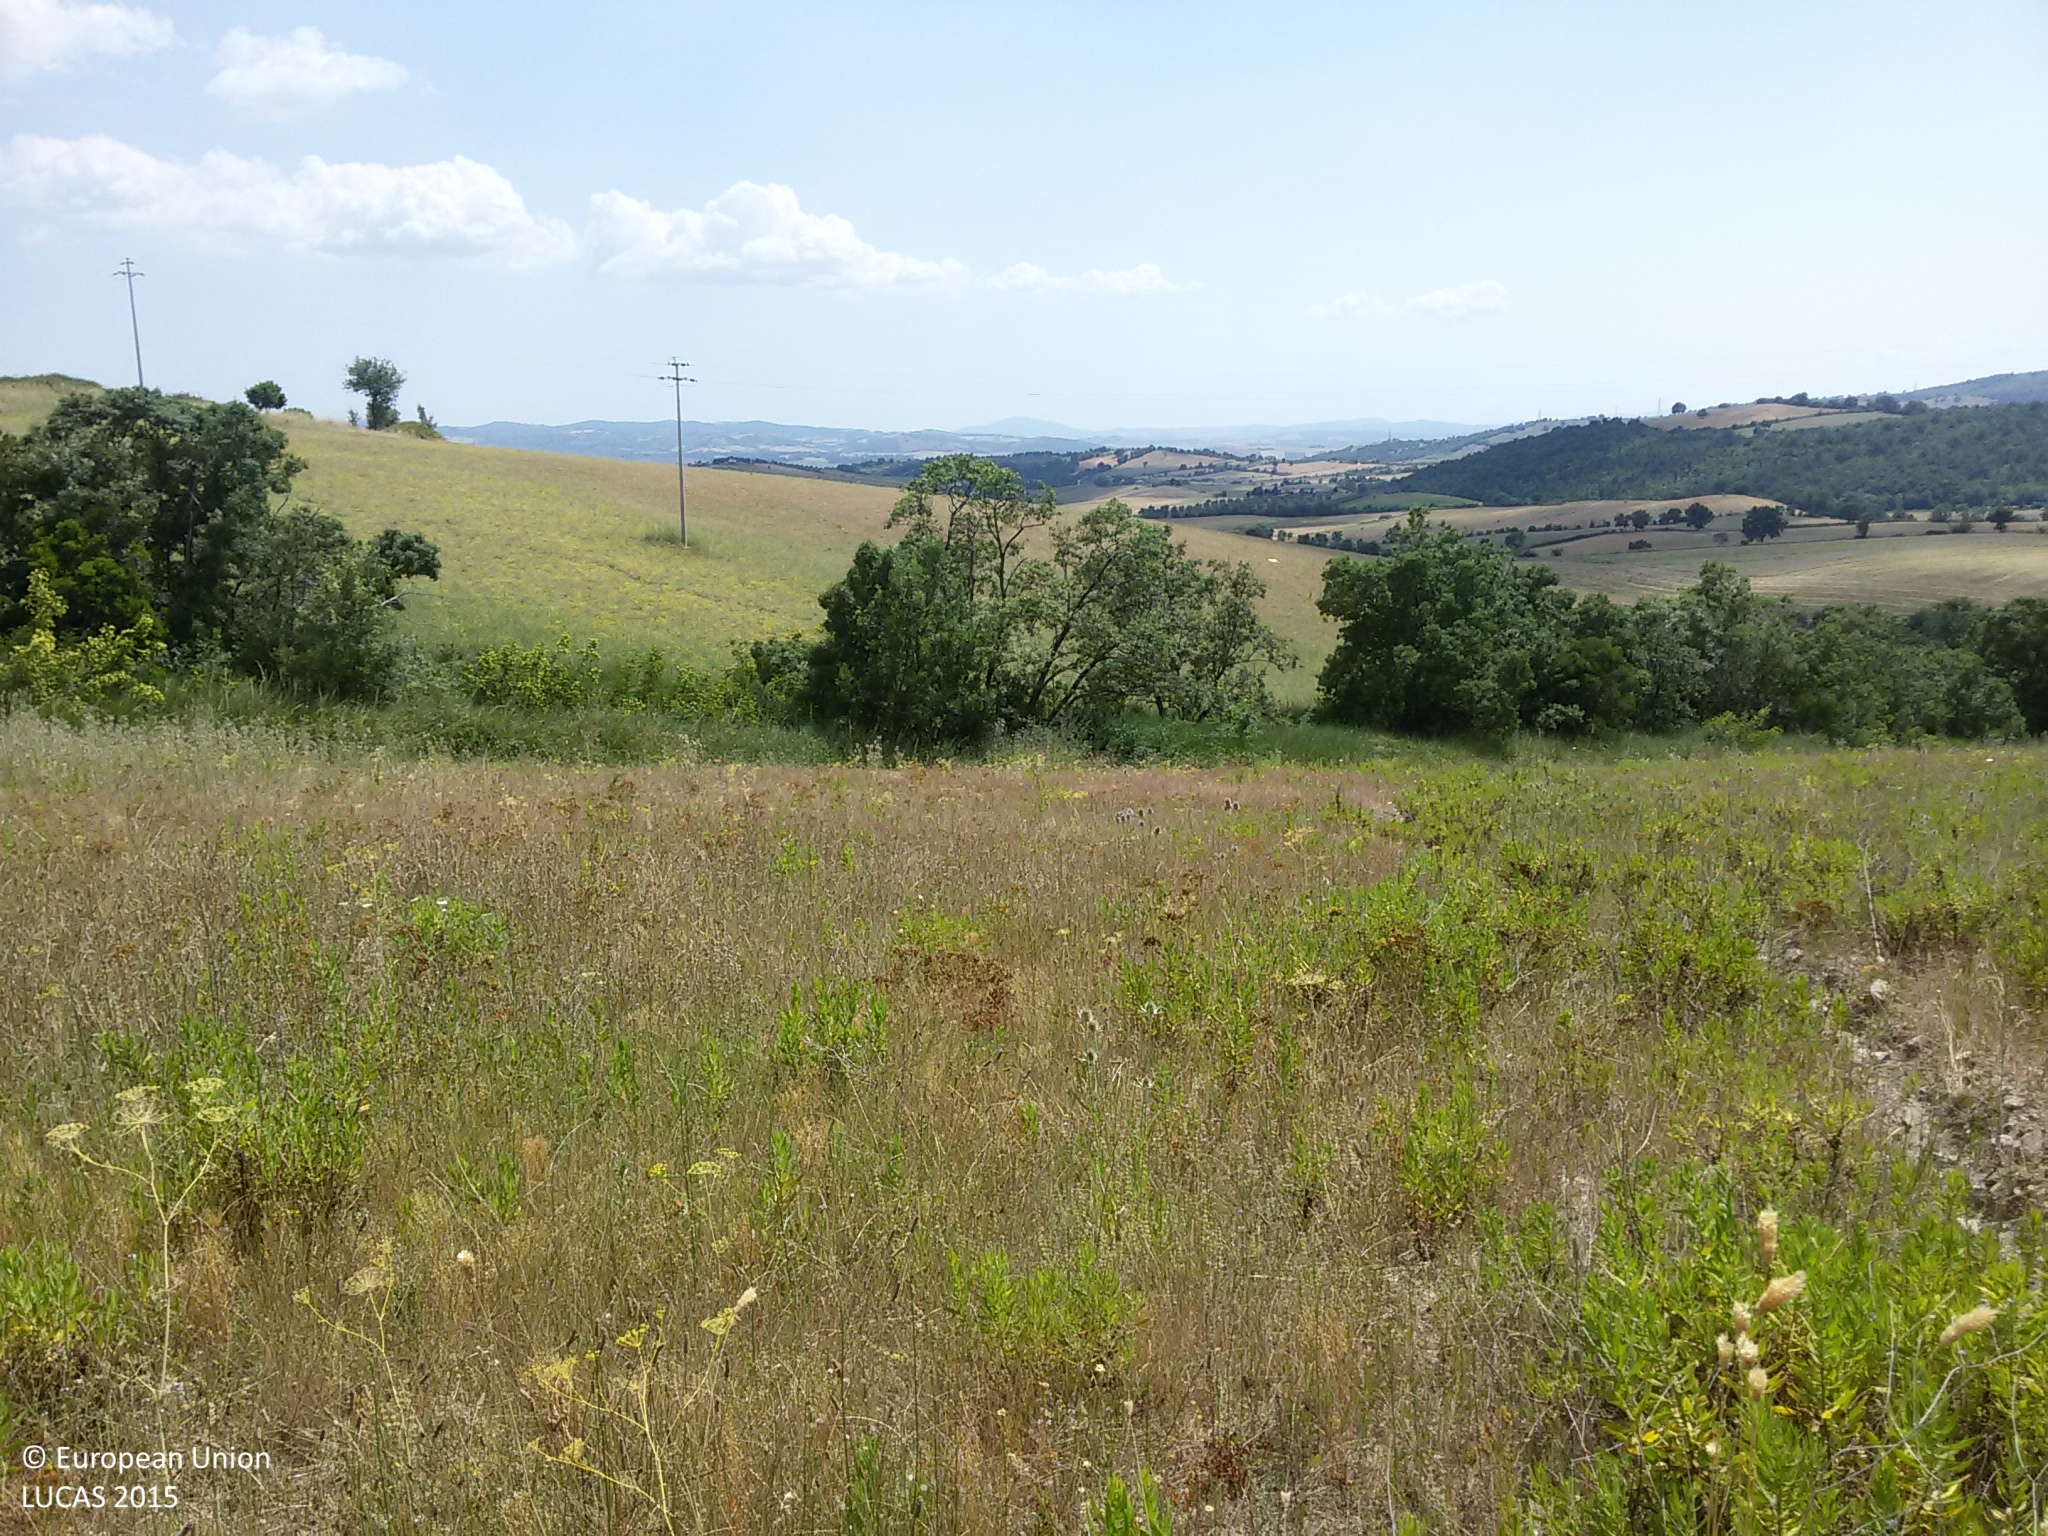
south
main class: Grassland
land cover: Grassland without tree/shrub cover
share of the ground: 50 - 75 %
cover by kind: herbaceous plants 90 %, consolidated bare surface 5 %, unconsolidated bare surface 5 %
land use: Agriculture (excluding fallow land and kitchen gardens)
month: July
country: IT
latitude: 42.7156
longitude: 11.4726
